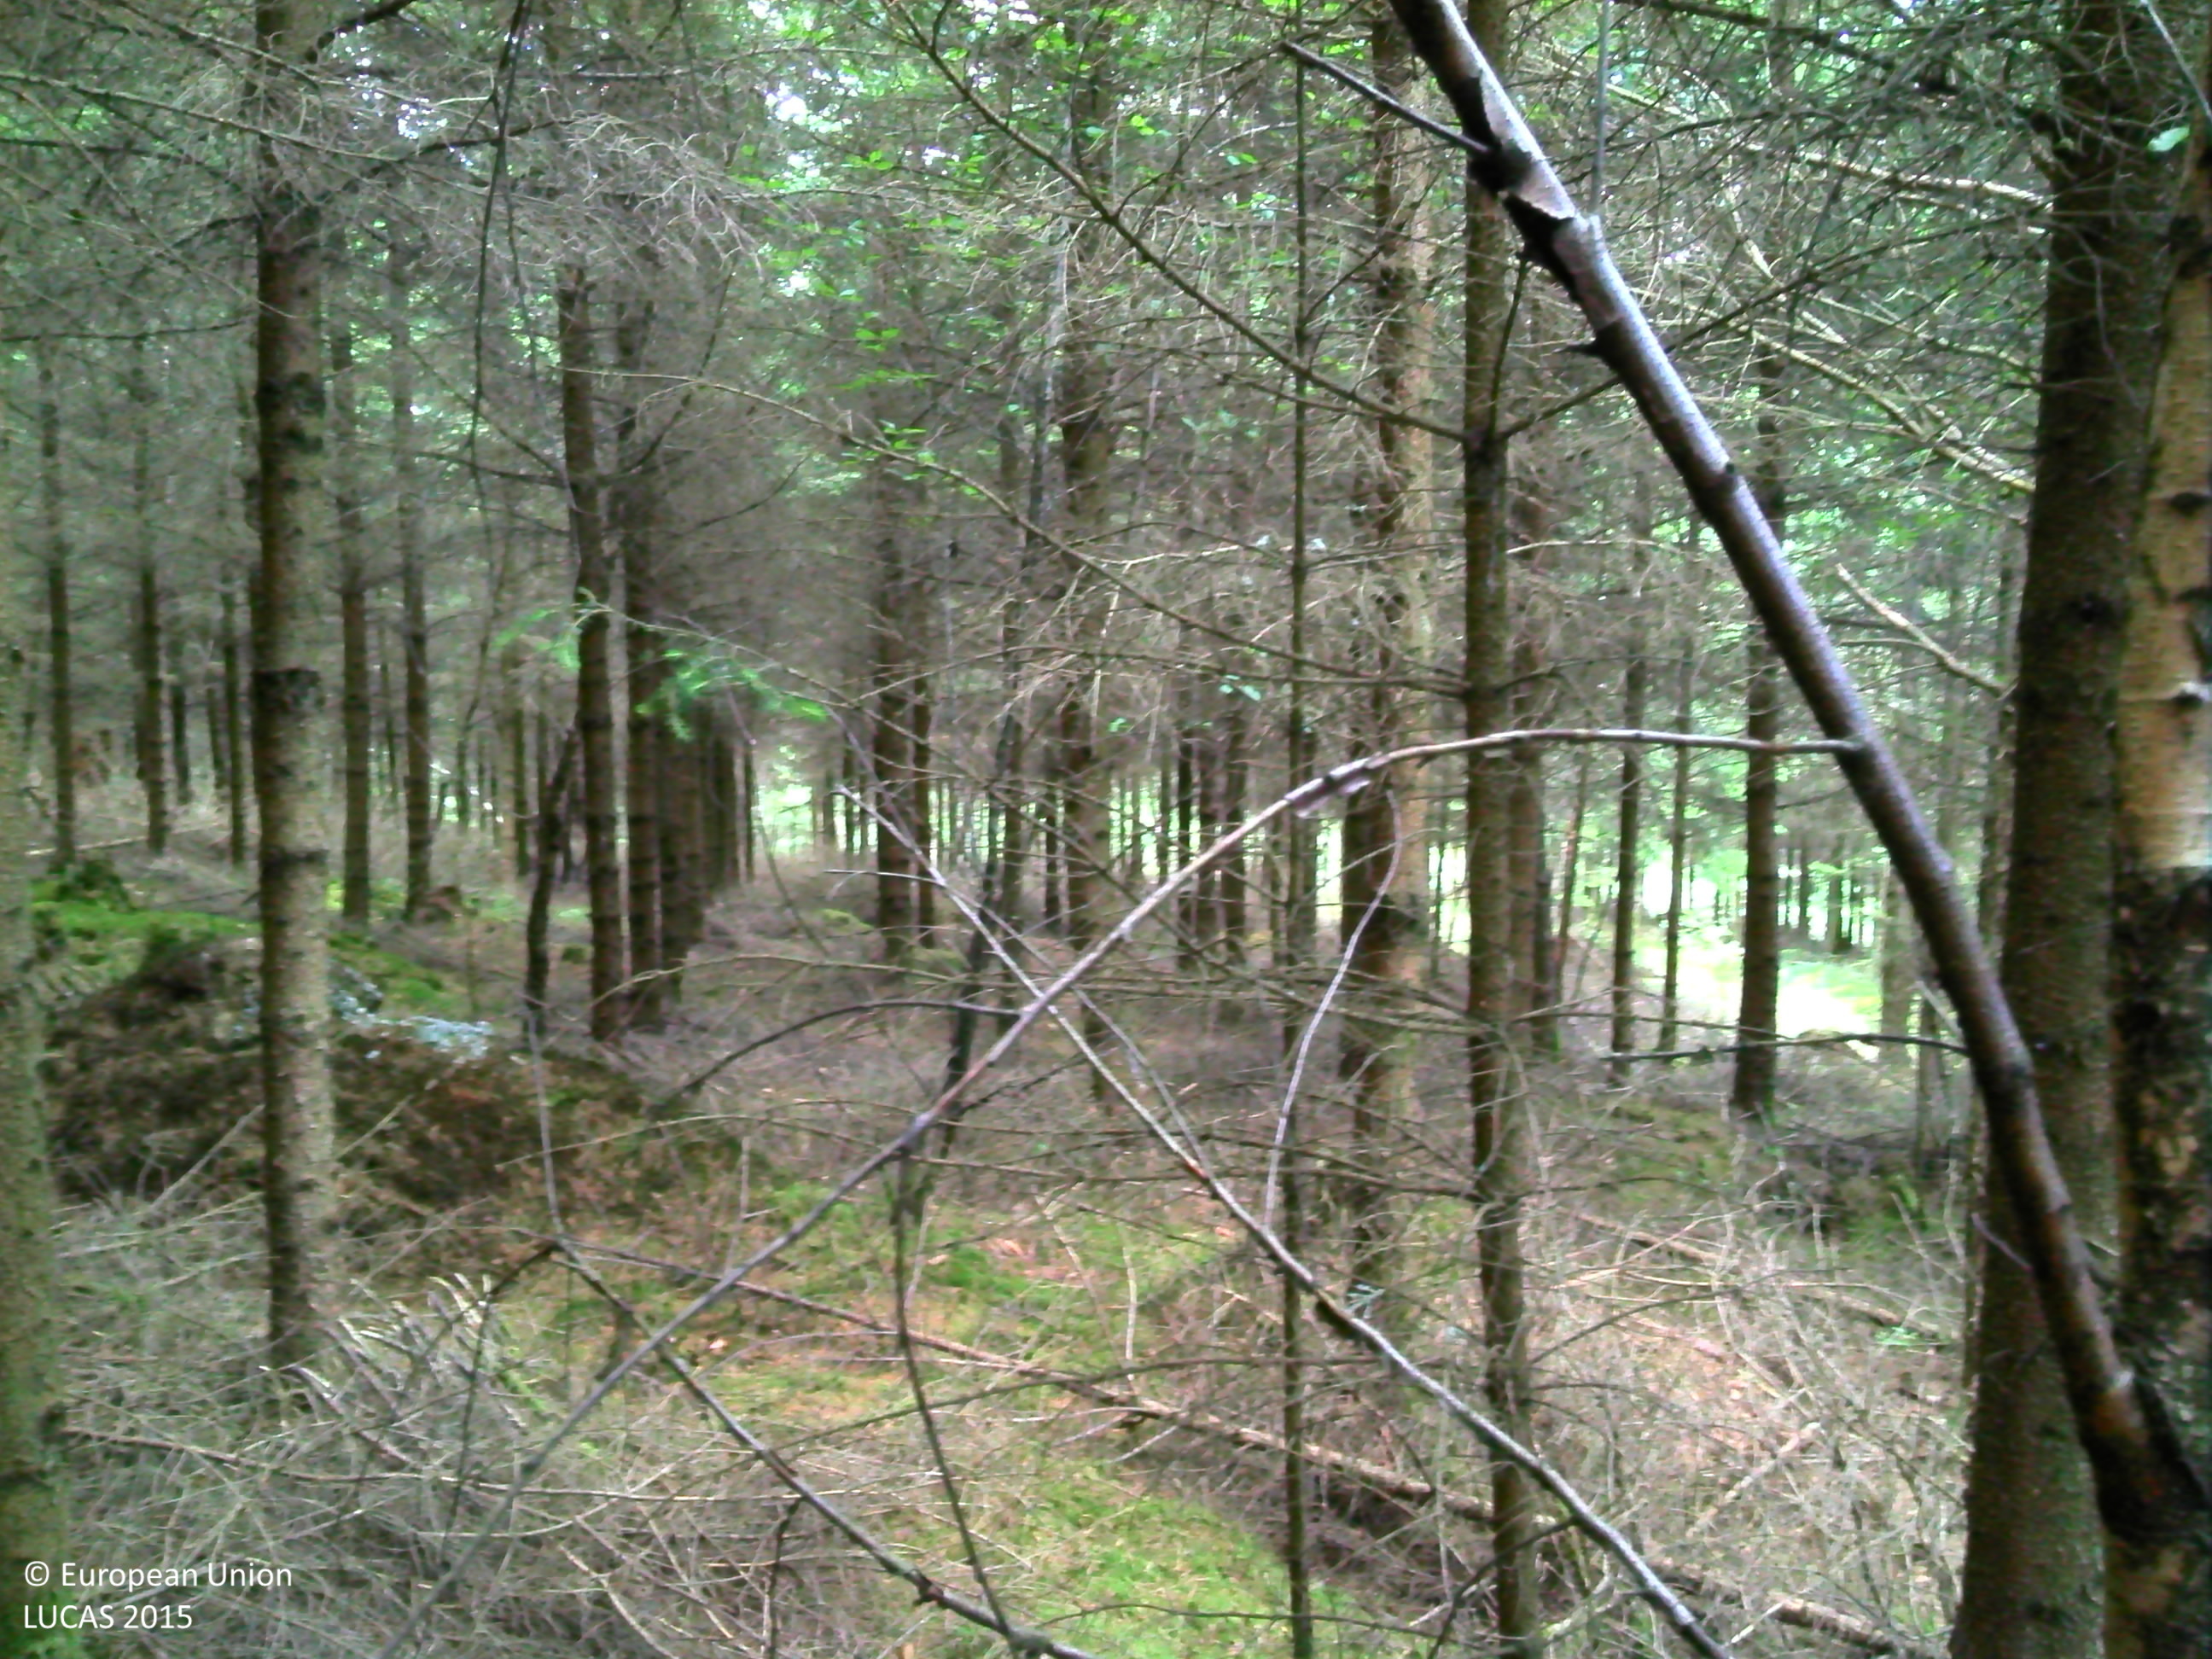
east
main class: Woodland
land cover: Spruce dominated coniferous woodland
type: exotic forest
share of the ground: > 75 %
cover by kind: coniferous forest trees 90 %, lichens and mosses 10 %
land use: Forestry
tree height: > 5 m
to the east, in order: Spruce dominated coniferous woodland; Tracks; Spruce dominated coniferous woodland; Broadleaved woodland; Tracks; Shrubland without tree cover; Rivers and streams; Shrubland without tree cover; Tracks; Spruce dominated coniferous woodland; Grass margins; Tracks; Grass margins; Spruce dominated mixed woodland; Grassland with sparse tree/shrub cover; Rivers and streams; Shrubland with sparse tree cover; Spontaneously vegetated surfaces
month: July
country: BE
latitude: 50.2658
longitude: 6.2256
